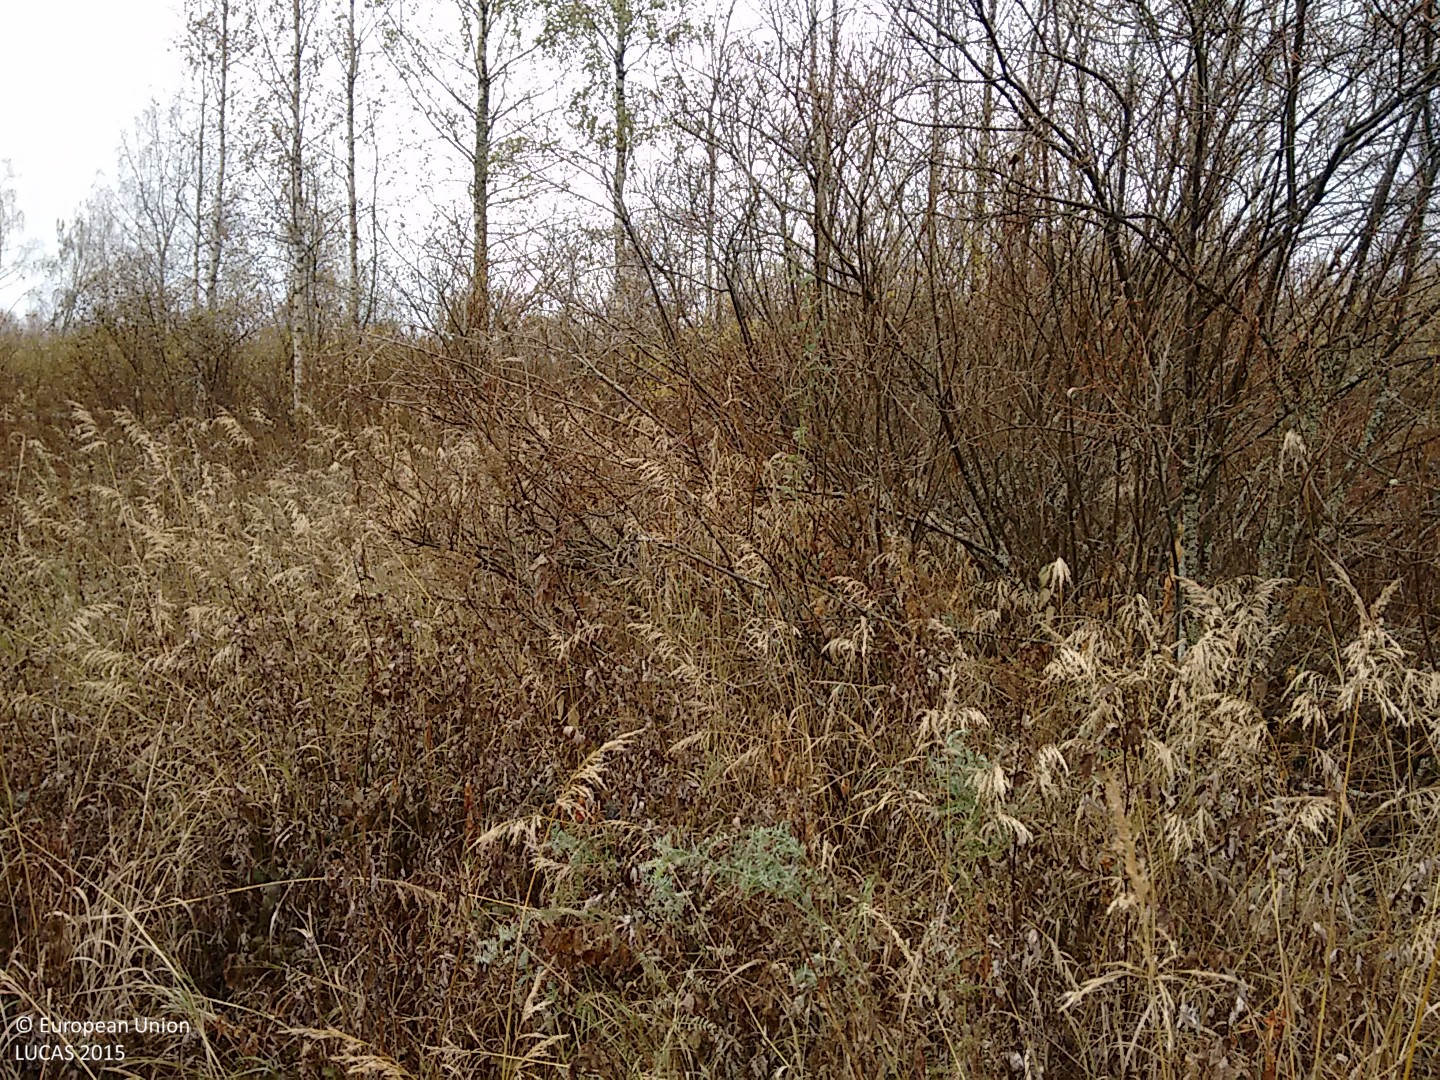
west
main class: Shrubland
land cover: Shrubland with sparse tree cover
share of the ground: 25 - 50 %
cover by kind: shrubs 45 %, herbaceous plants 45 %, broadleaved forest trees 5 %, lichens and mosses 5 %
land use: Forestry
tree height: < 5 m
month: October
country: FI
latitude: 62.6702
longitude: 26.3562
